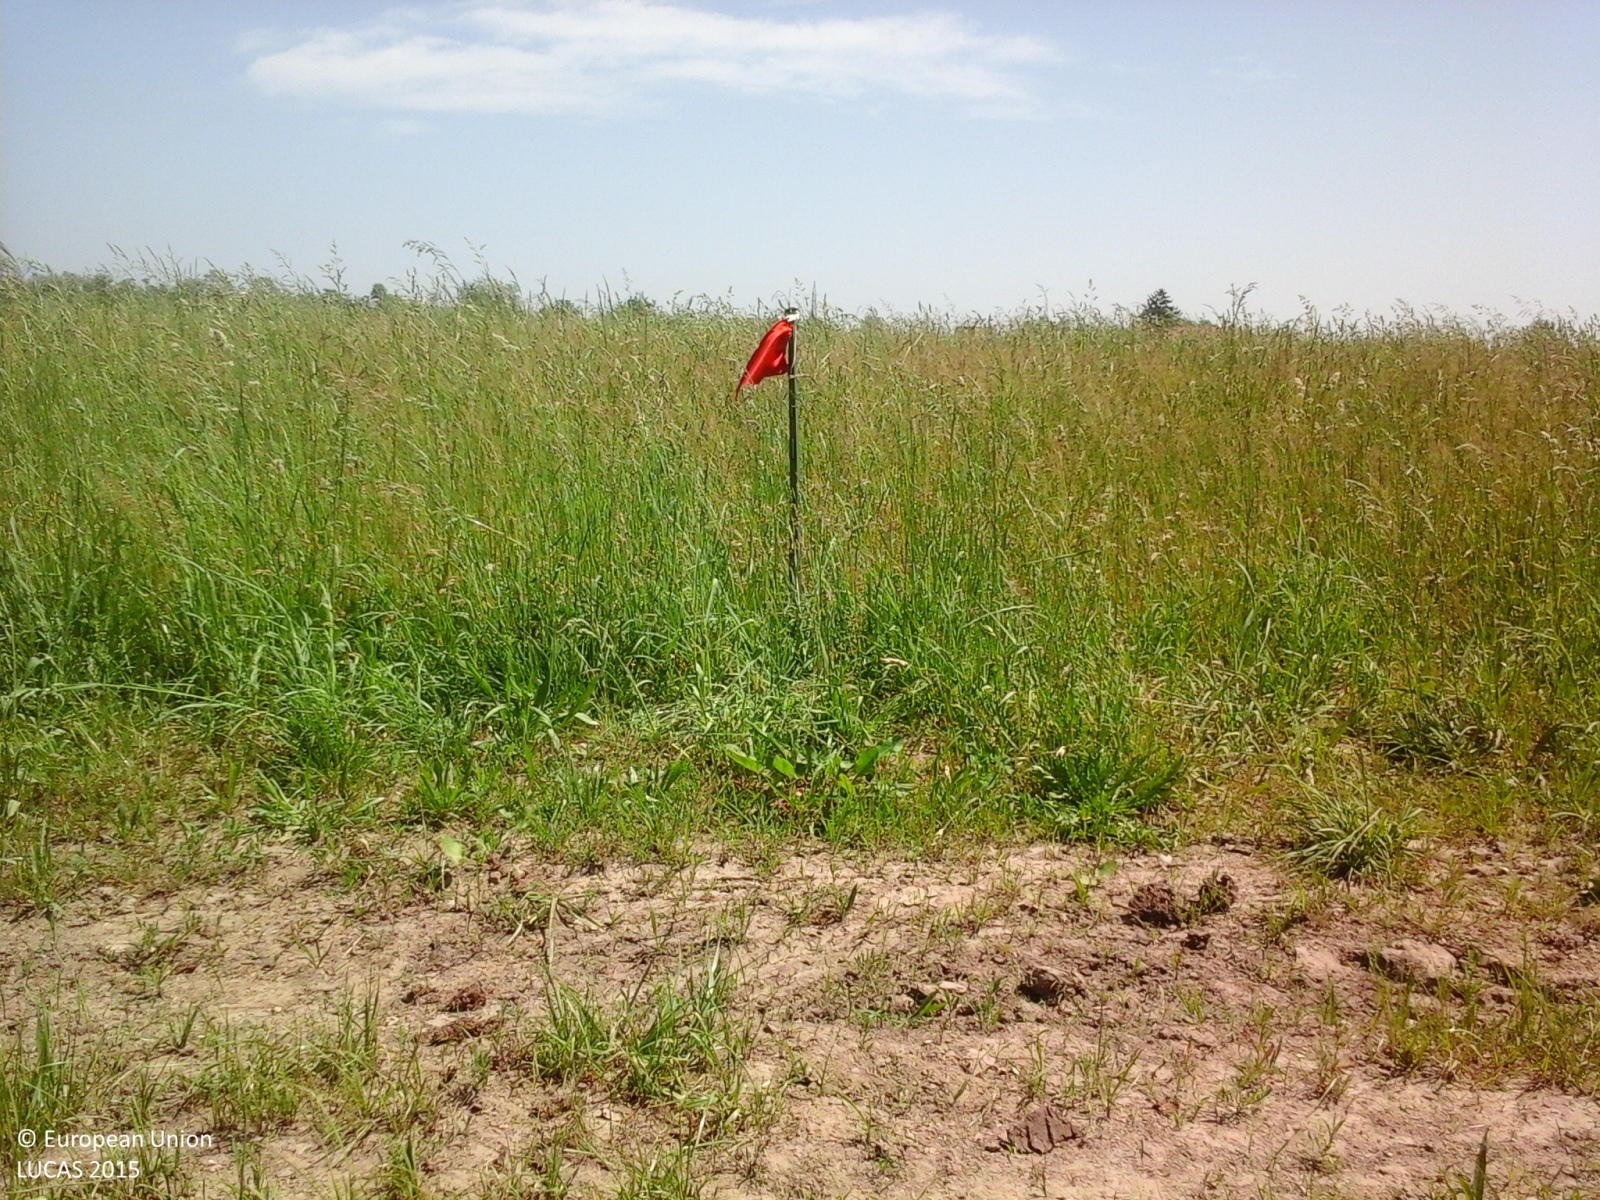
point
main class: Grassland
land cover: Grassland without tree/shrub cover
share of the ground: > 75 %
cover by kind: herbaceous plants 100 %
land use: Agriculture (excluding fallow land and kitchen gardens)
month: May
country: IT
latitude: 45.5316
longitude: 8.6321
